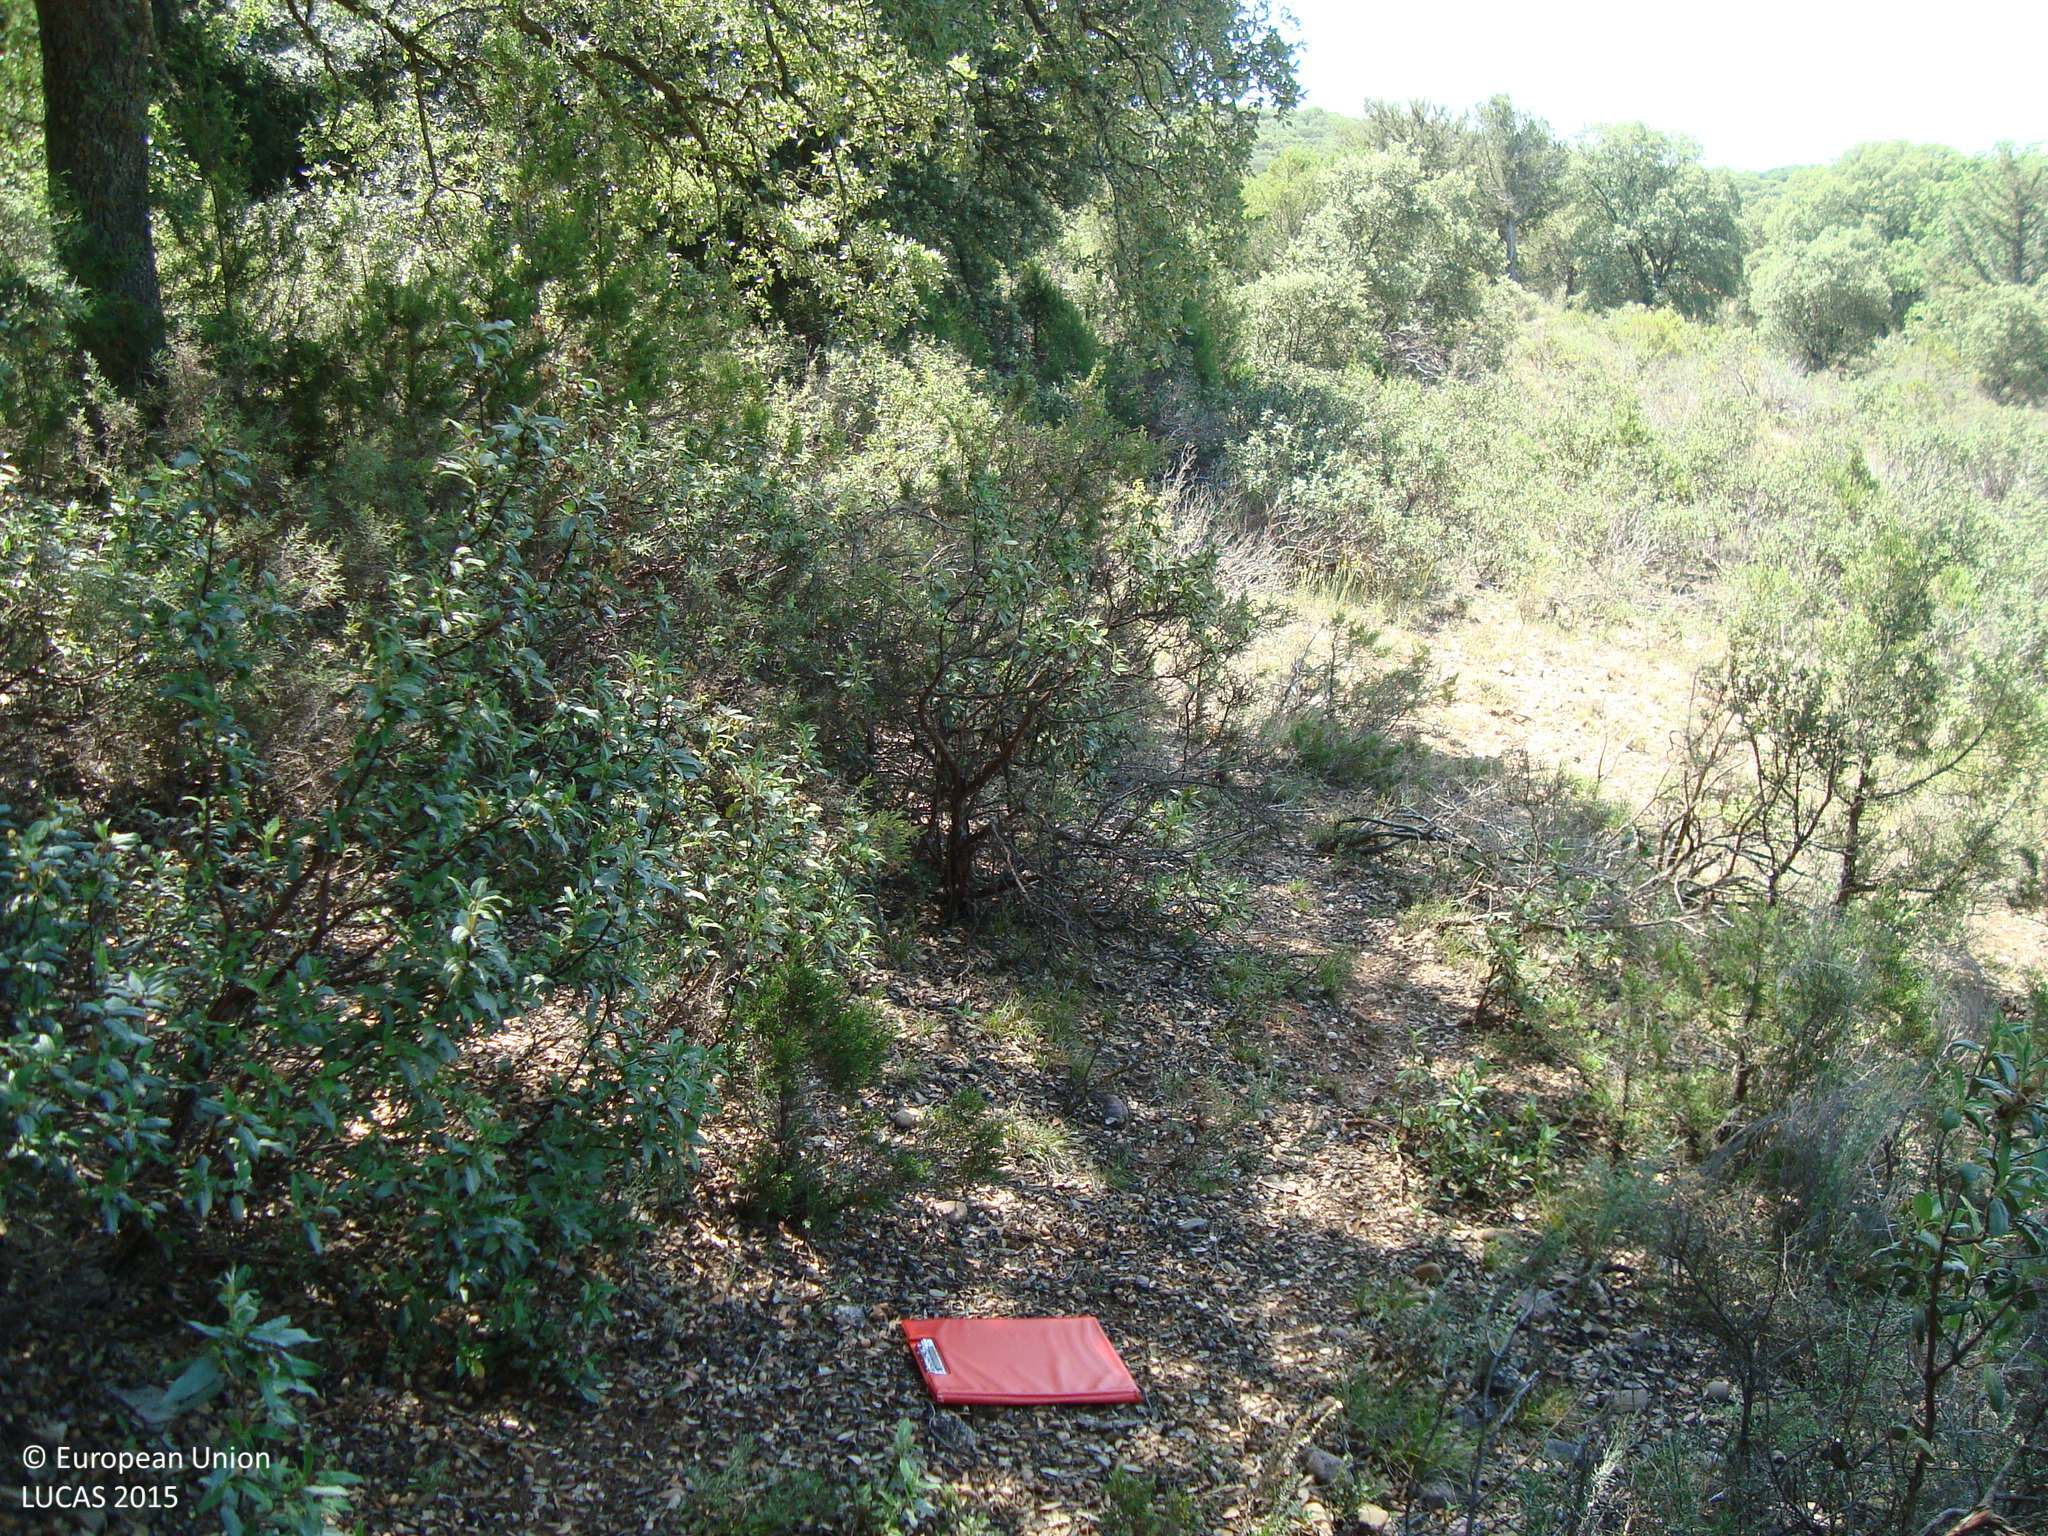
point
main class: Woodland
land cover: Broadleaved woodland
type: broadleaved evergreen forest
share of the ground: 25 - 50 %
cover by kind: broadleaved forest trees 40 %, shrubs 40 %, herbaceous plants 10 %, coniferous forest trees 5 %, unconsolidated bare surface 5 %
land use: Forestry
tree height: > 5 m
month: June
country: ES
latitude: 42.0655
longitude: -3.7017
